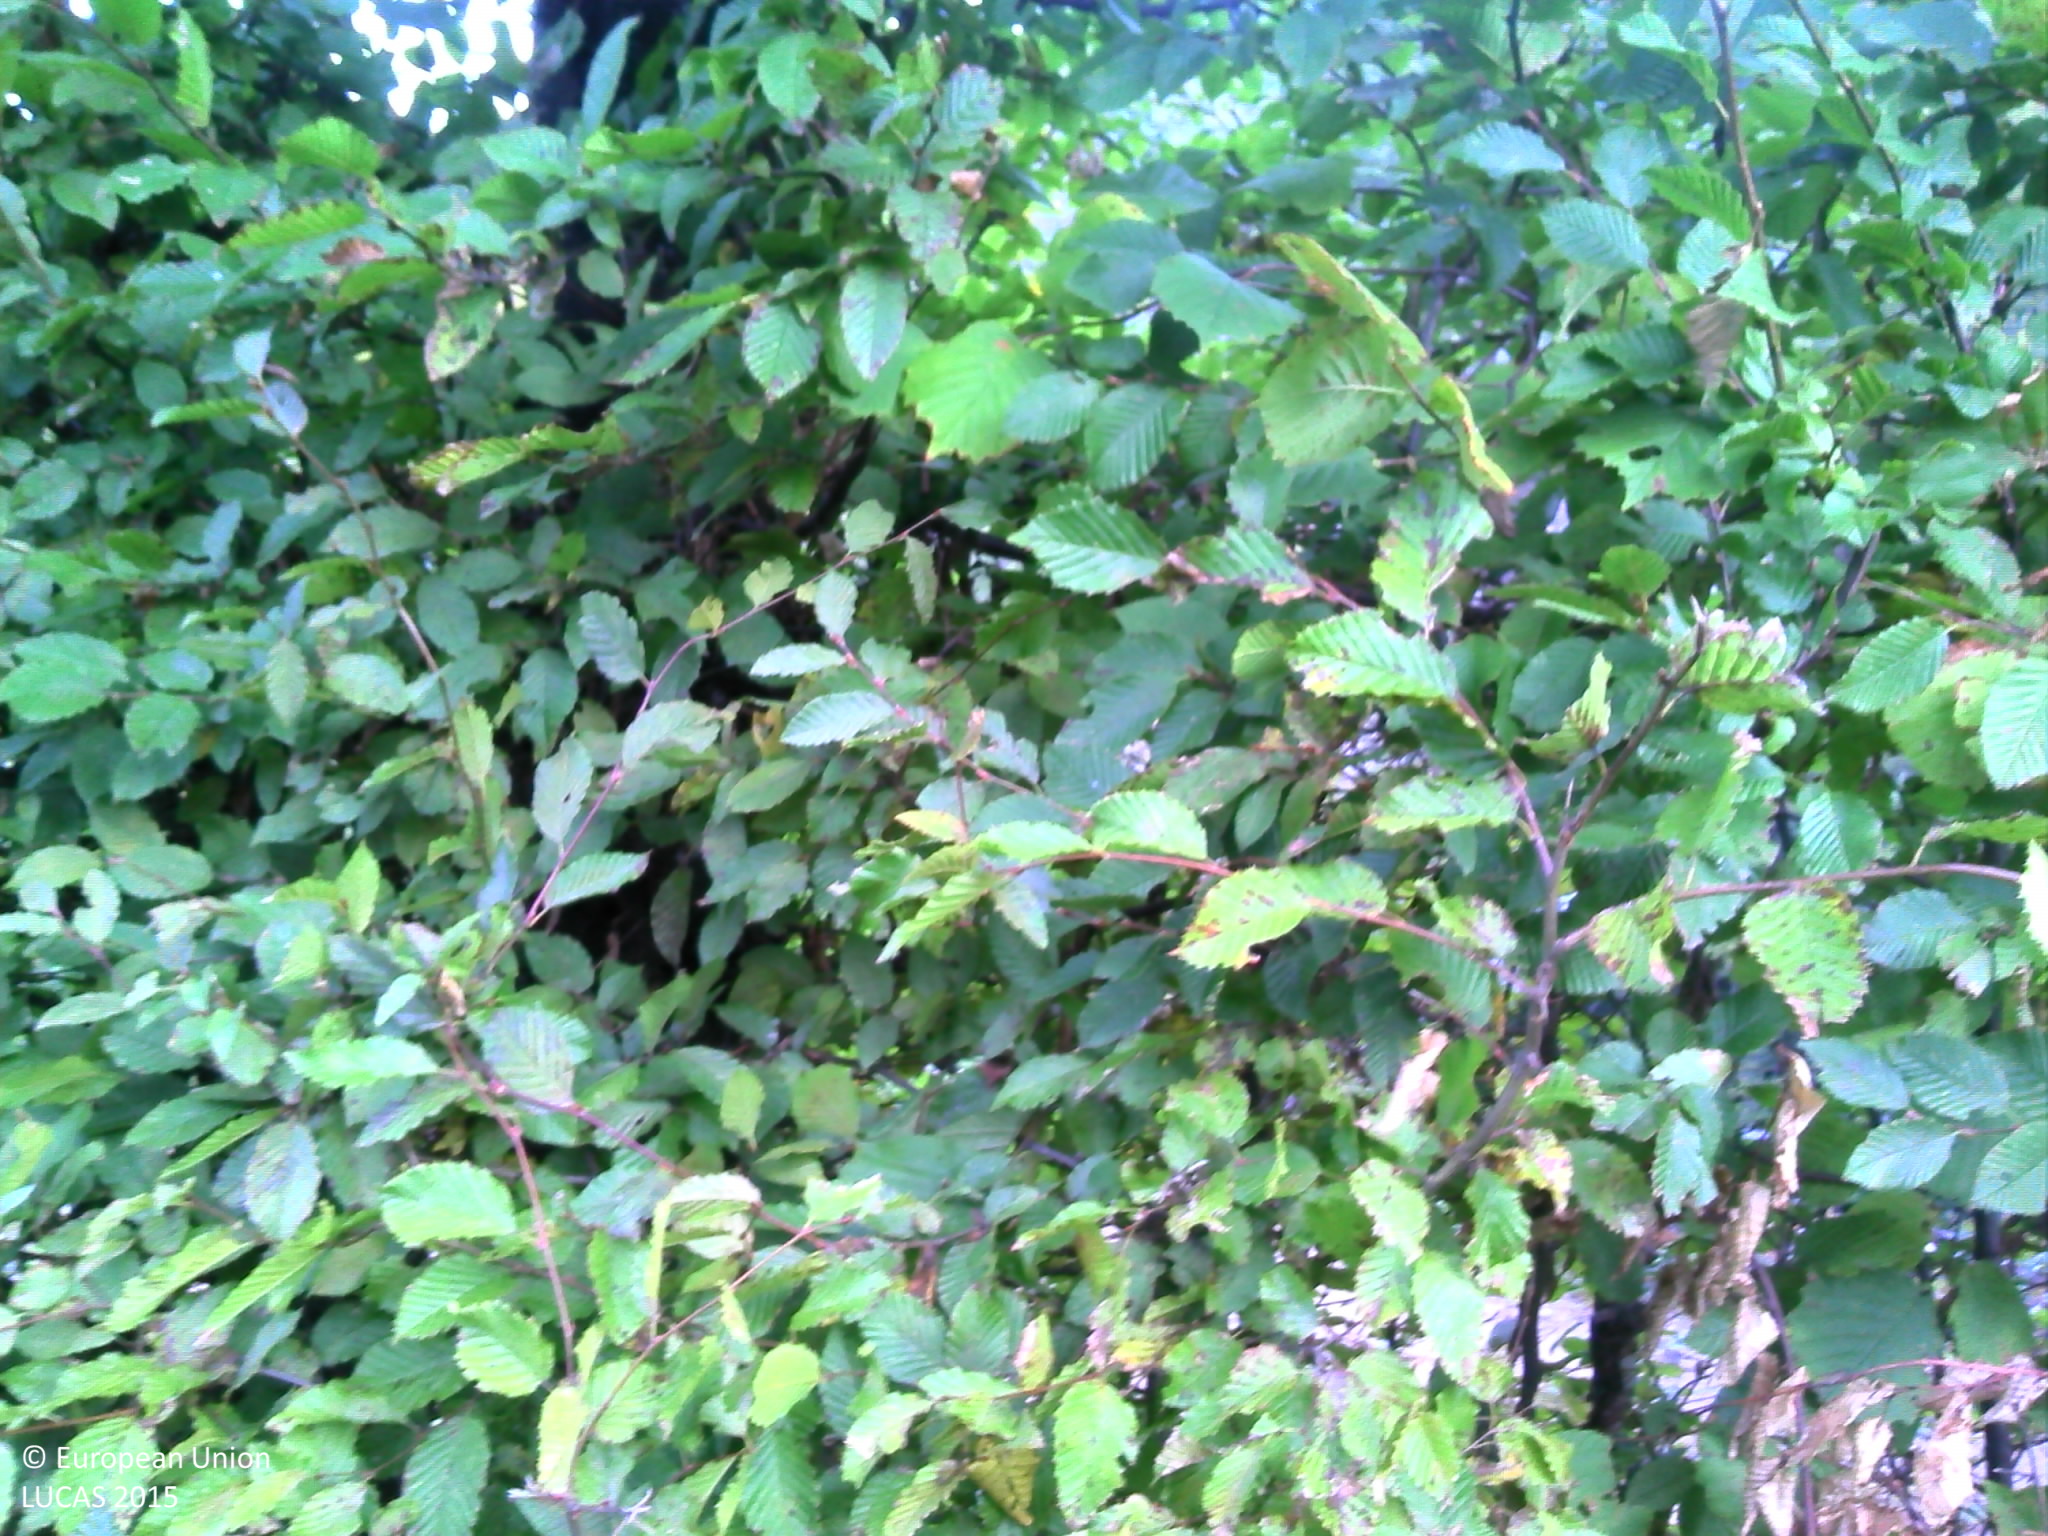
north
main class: Woodland
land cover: Broadleaved woodland
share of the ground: > 75 %
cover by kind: broadleaved forest trees 95 %, herbaceous plants 5 %
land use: Semi-natural and natural areas not in use
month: September
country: FR
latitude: 45.3997
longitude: 4.5492
